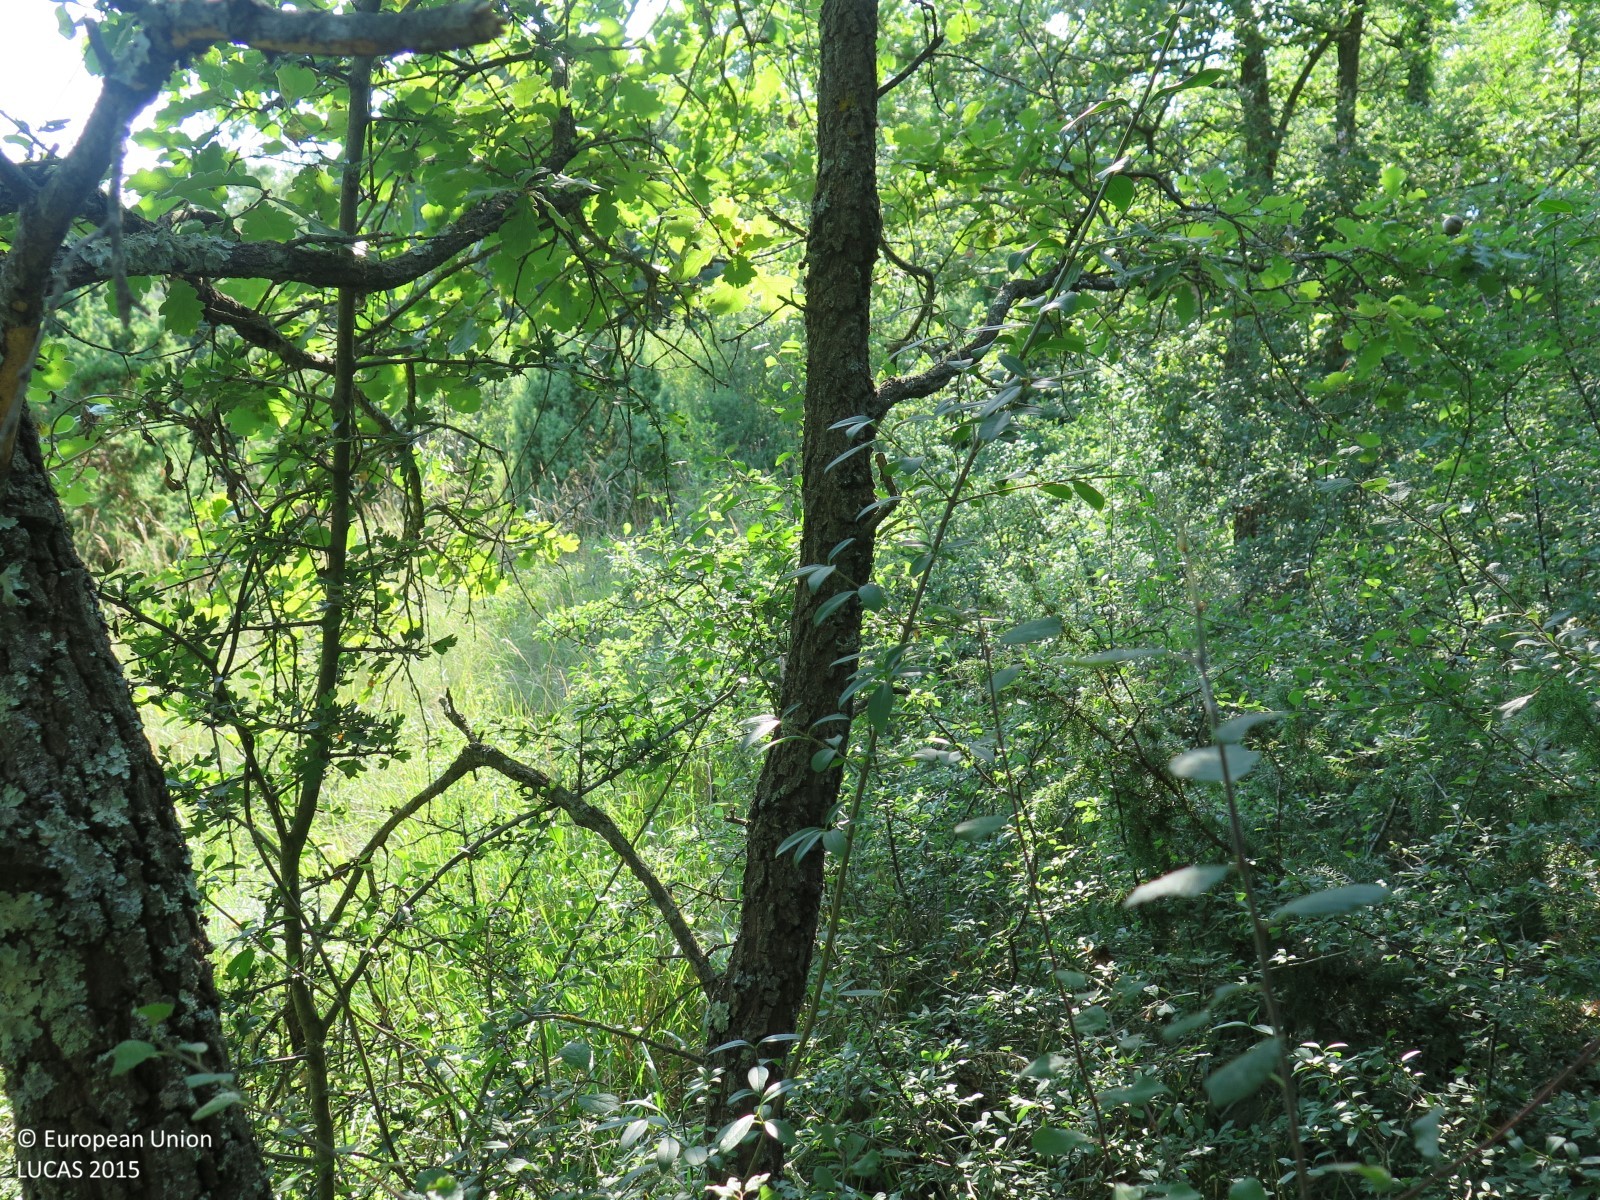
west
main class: Shrubland
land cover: Shrubland with sparse tree cover
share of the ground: > 75 %
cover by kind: shrubs 90 %, broadleaved forest trees 5 %, herbaceous plants 5 %
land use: Semi-natural and natural areas not in use
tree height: > 5 m
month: July
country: HR
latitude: 45.2375
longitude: 13.8037
